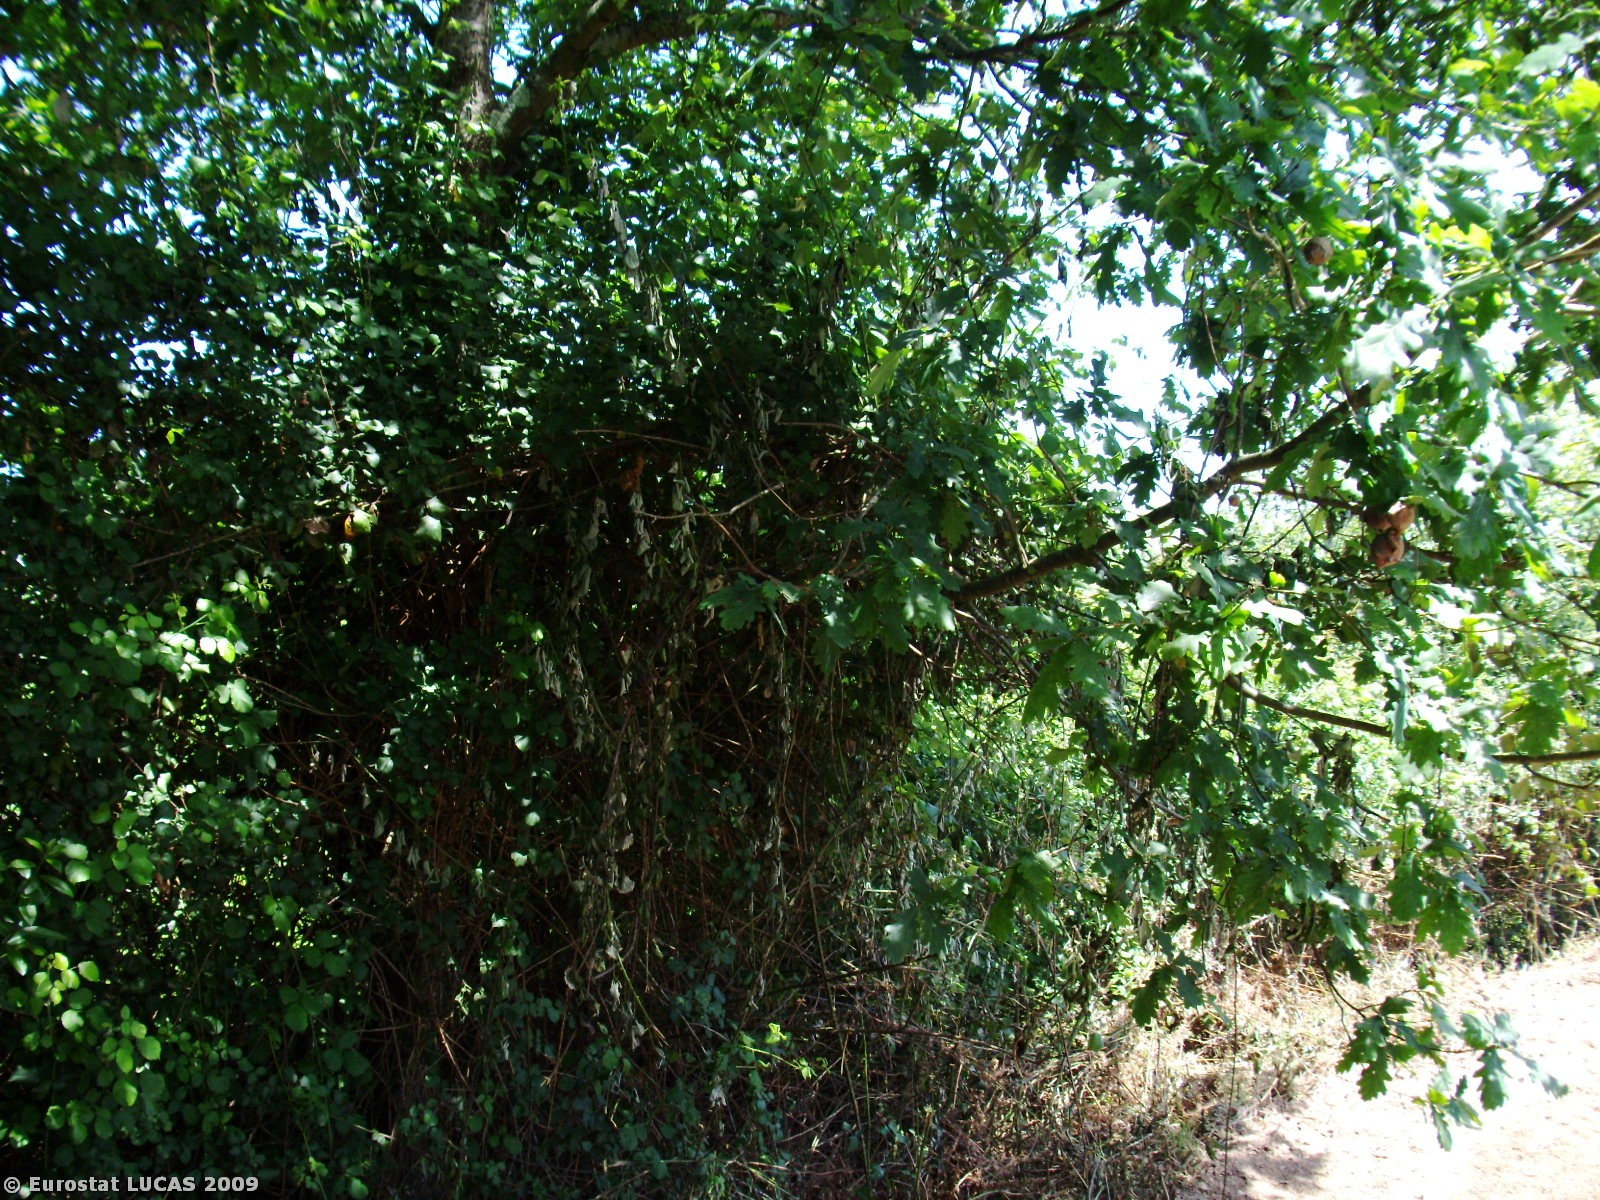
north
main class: Shrubland
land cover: Shrubland with sparse tree cover
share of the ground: > 75 %
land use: Fallow land
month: May
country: PT
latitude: 41.6494
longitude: -8.6162
